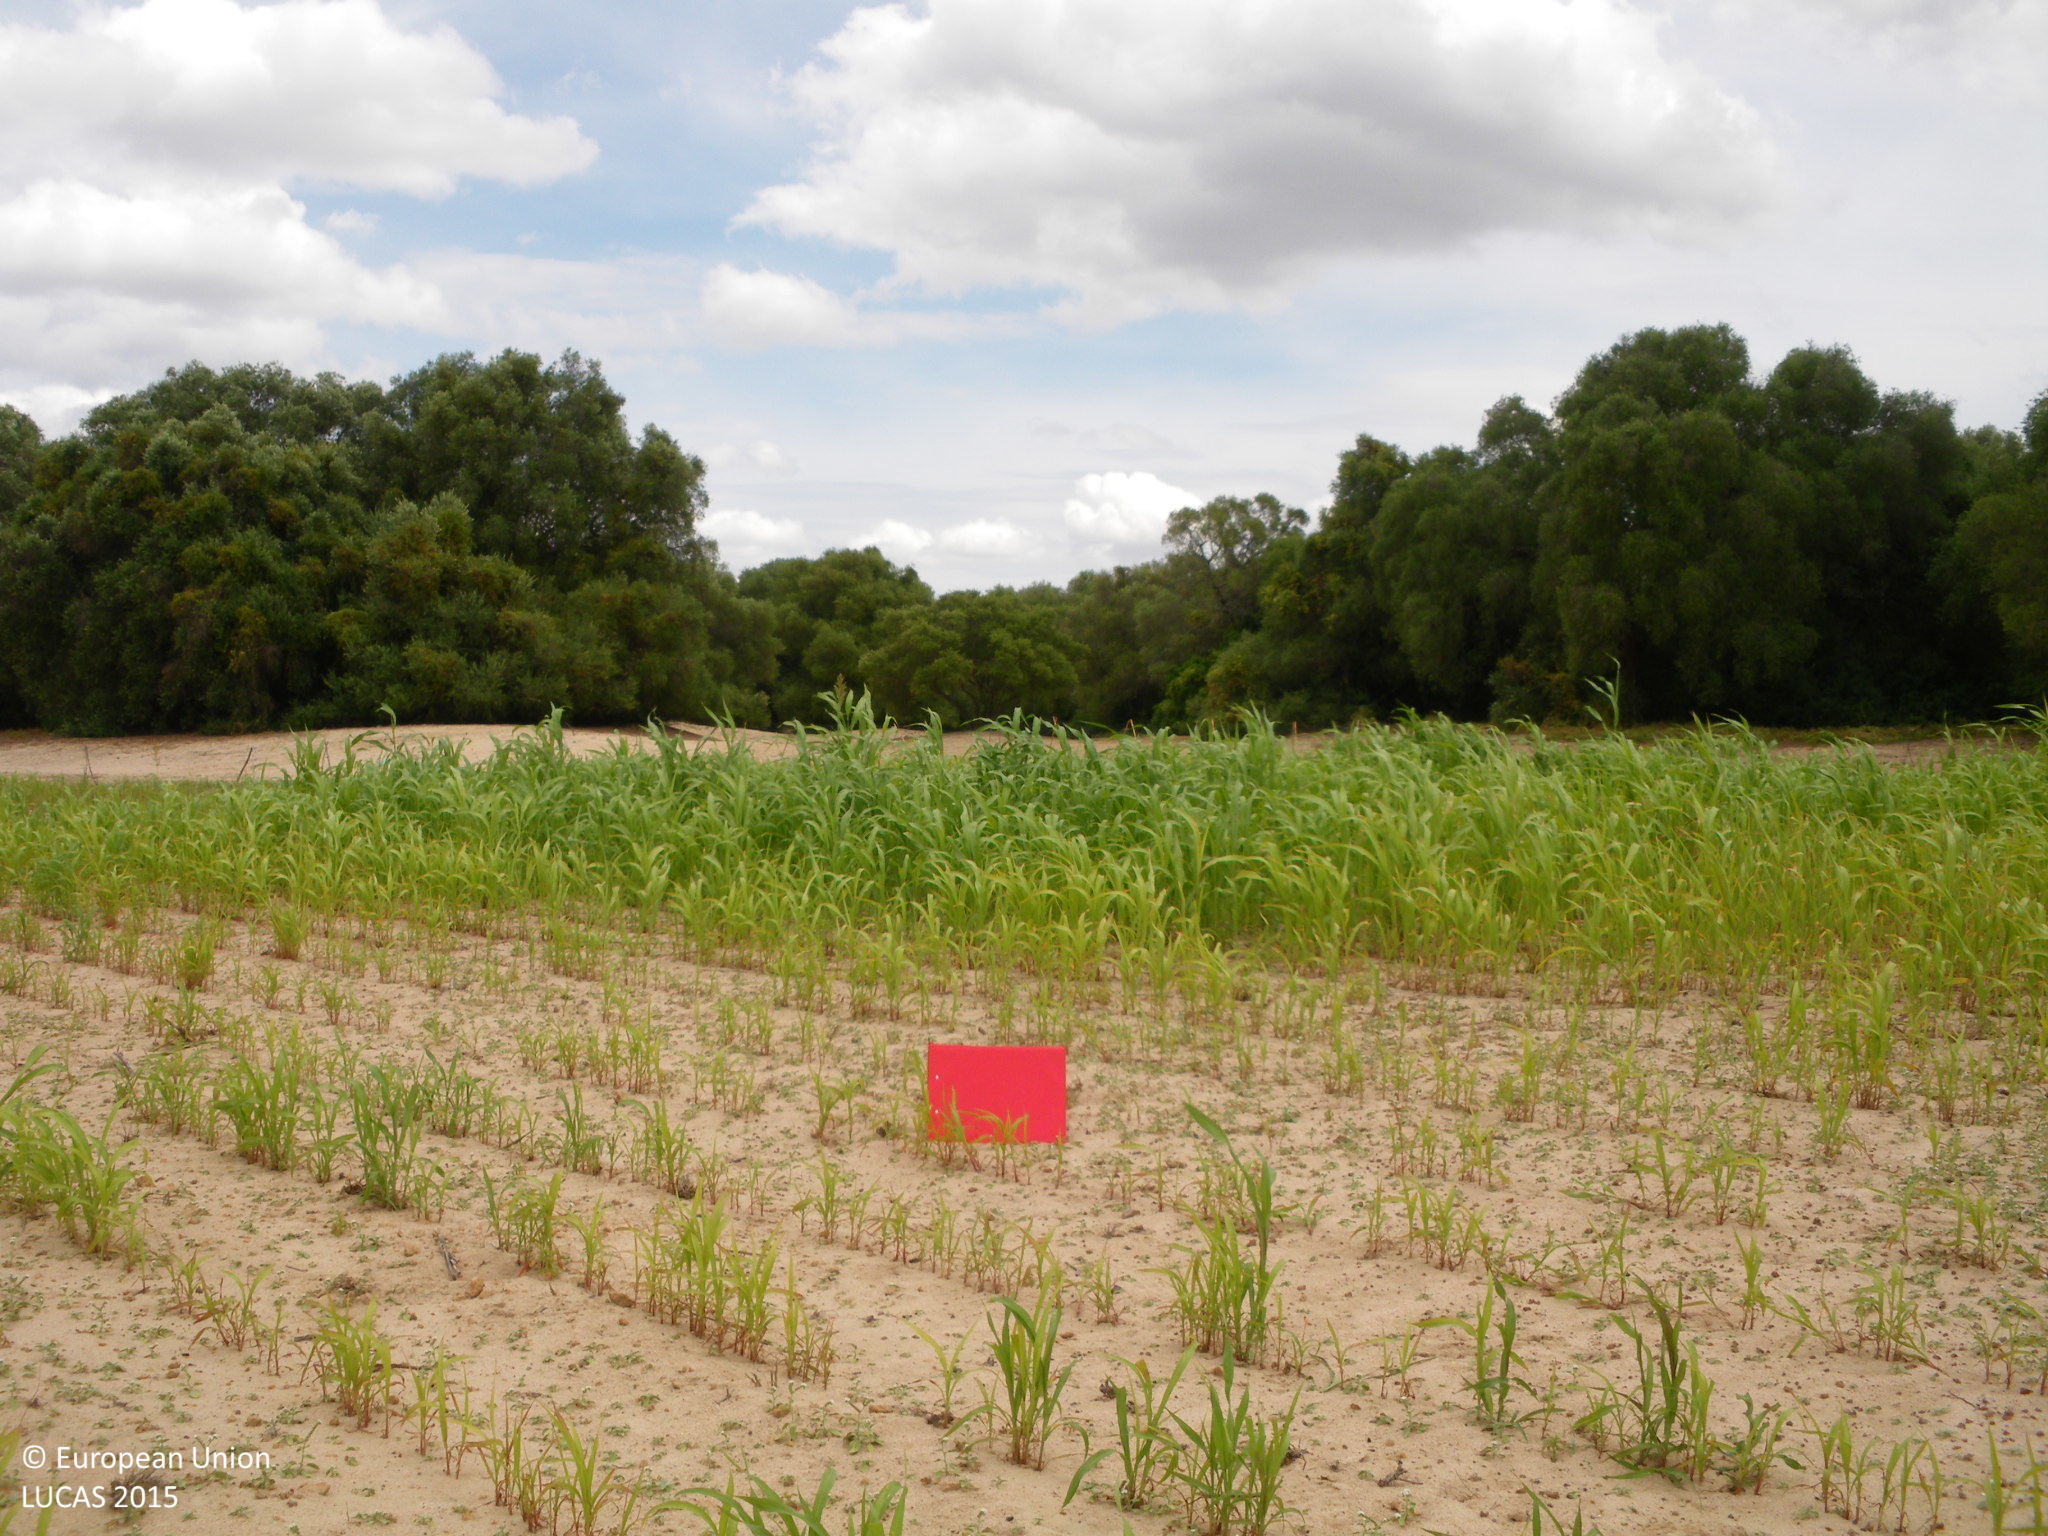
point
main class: Cropland
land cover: Other cereals
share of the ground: < 10 %
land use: Agriculture (excluding fallow land and kitchen gardens)
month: June
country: ES
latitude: 36.3309
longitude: -5.8758
